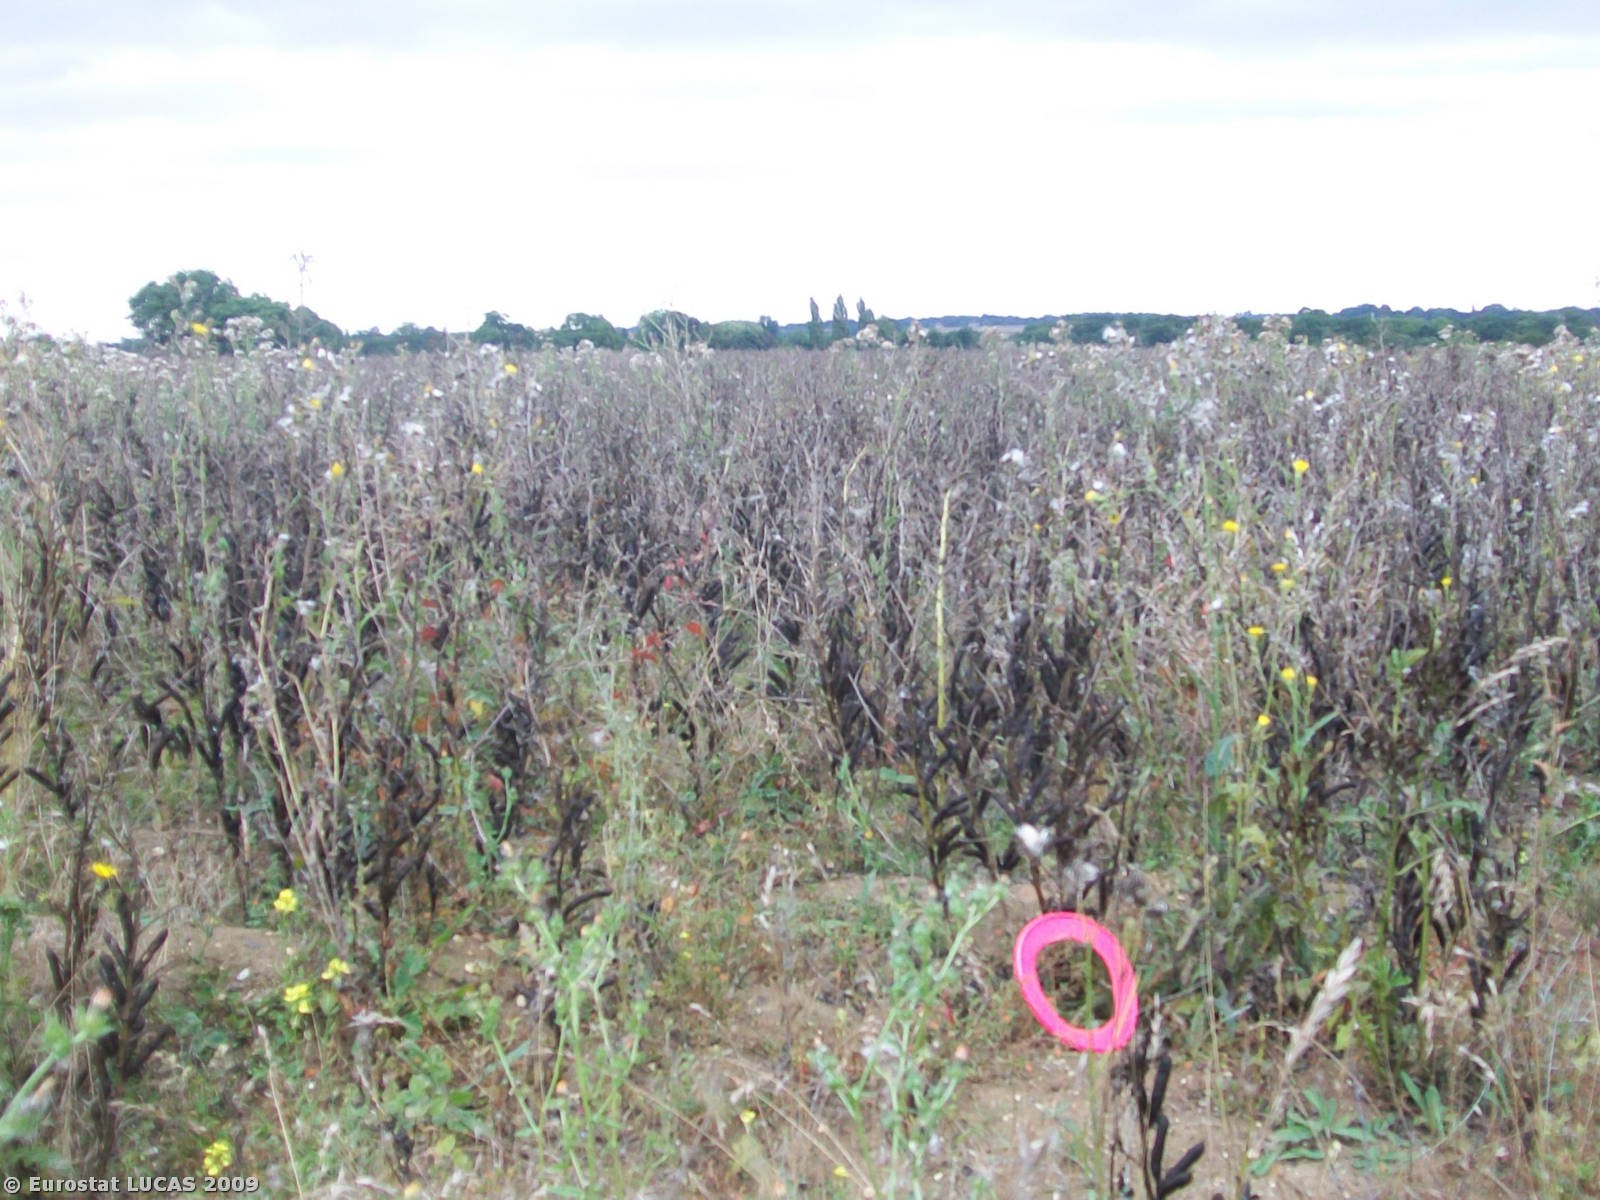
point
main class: Cropland
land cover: Dry pulses
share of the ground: > 75 %
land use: Agriculture (excluding fallow land and kitchen gardens)
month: August
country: GB
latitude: 51.8015
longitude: 0.1219
